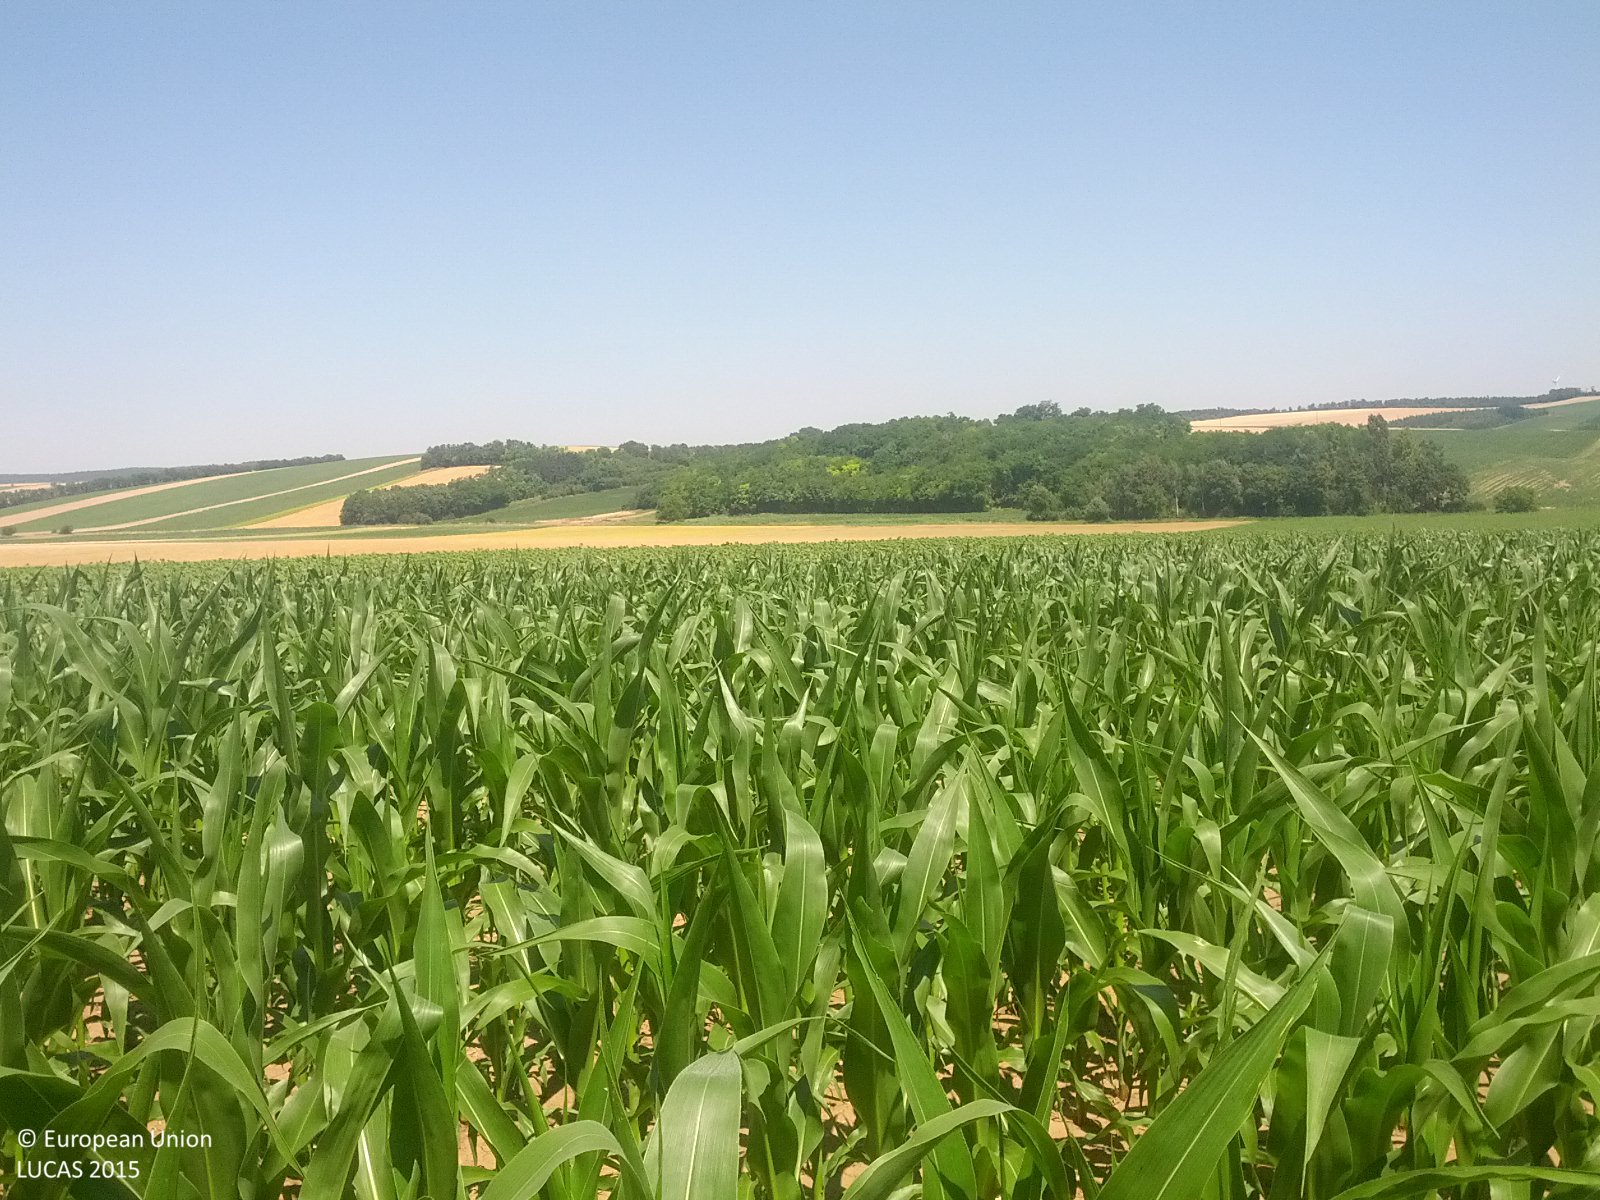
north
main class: Cropland
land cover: Maize
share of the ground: > 75 %
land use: Agriculture (excluding fallow land and kitchen gardens)
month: July
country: AT
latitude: 48.5880
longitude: 16.5545
